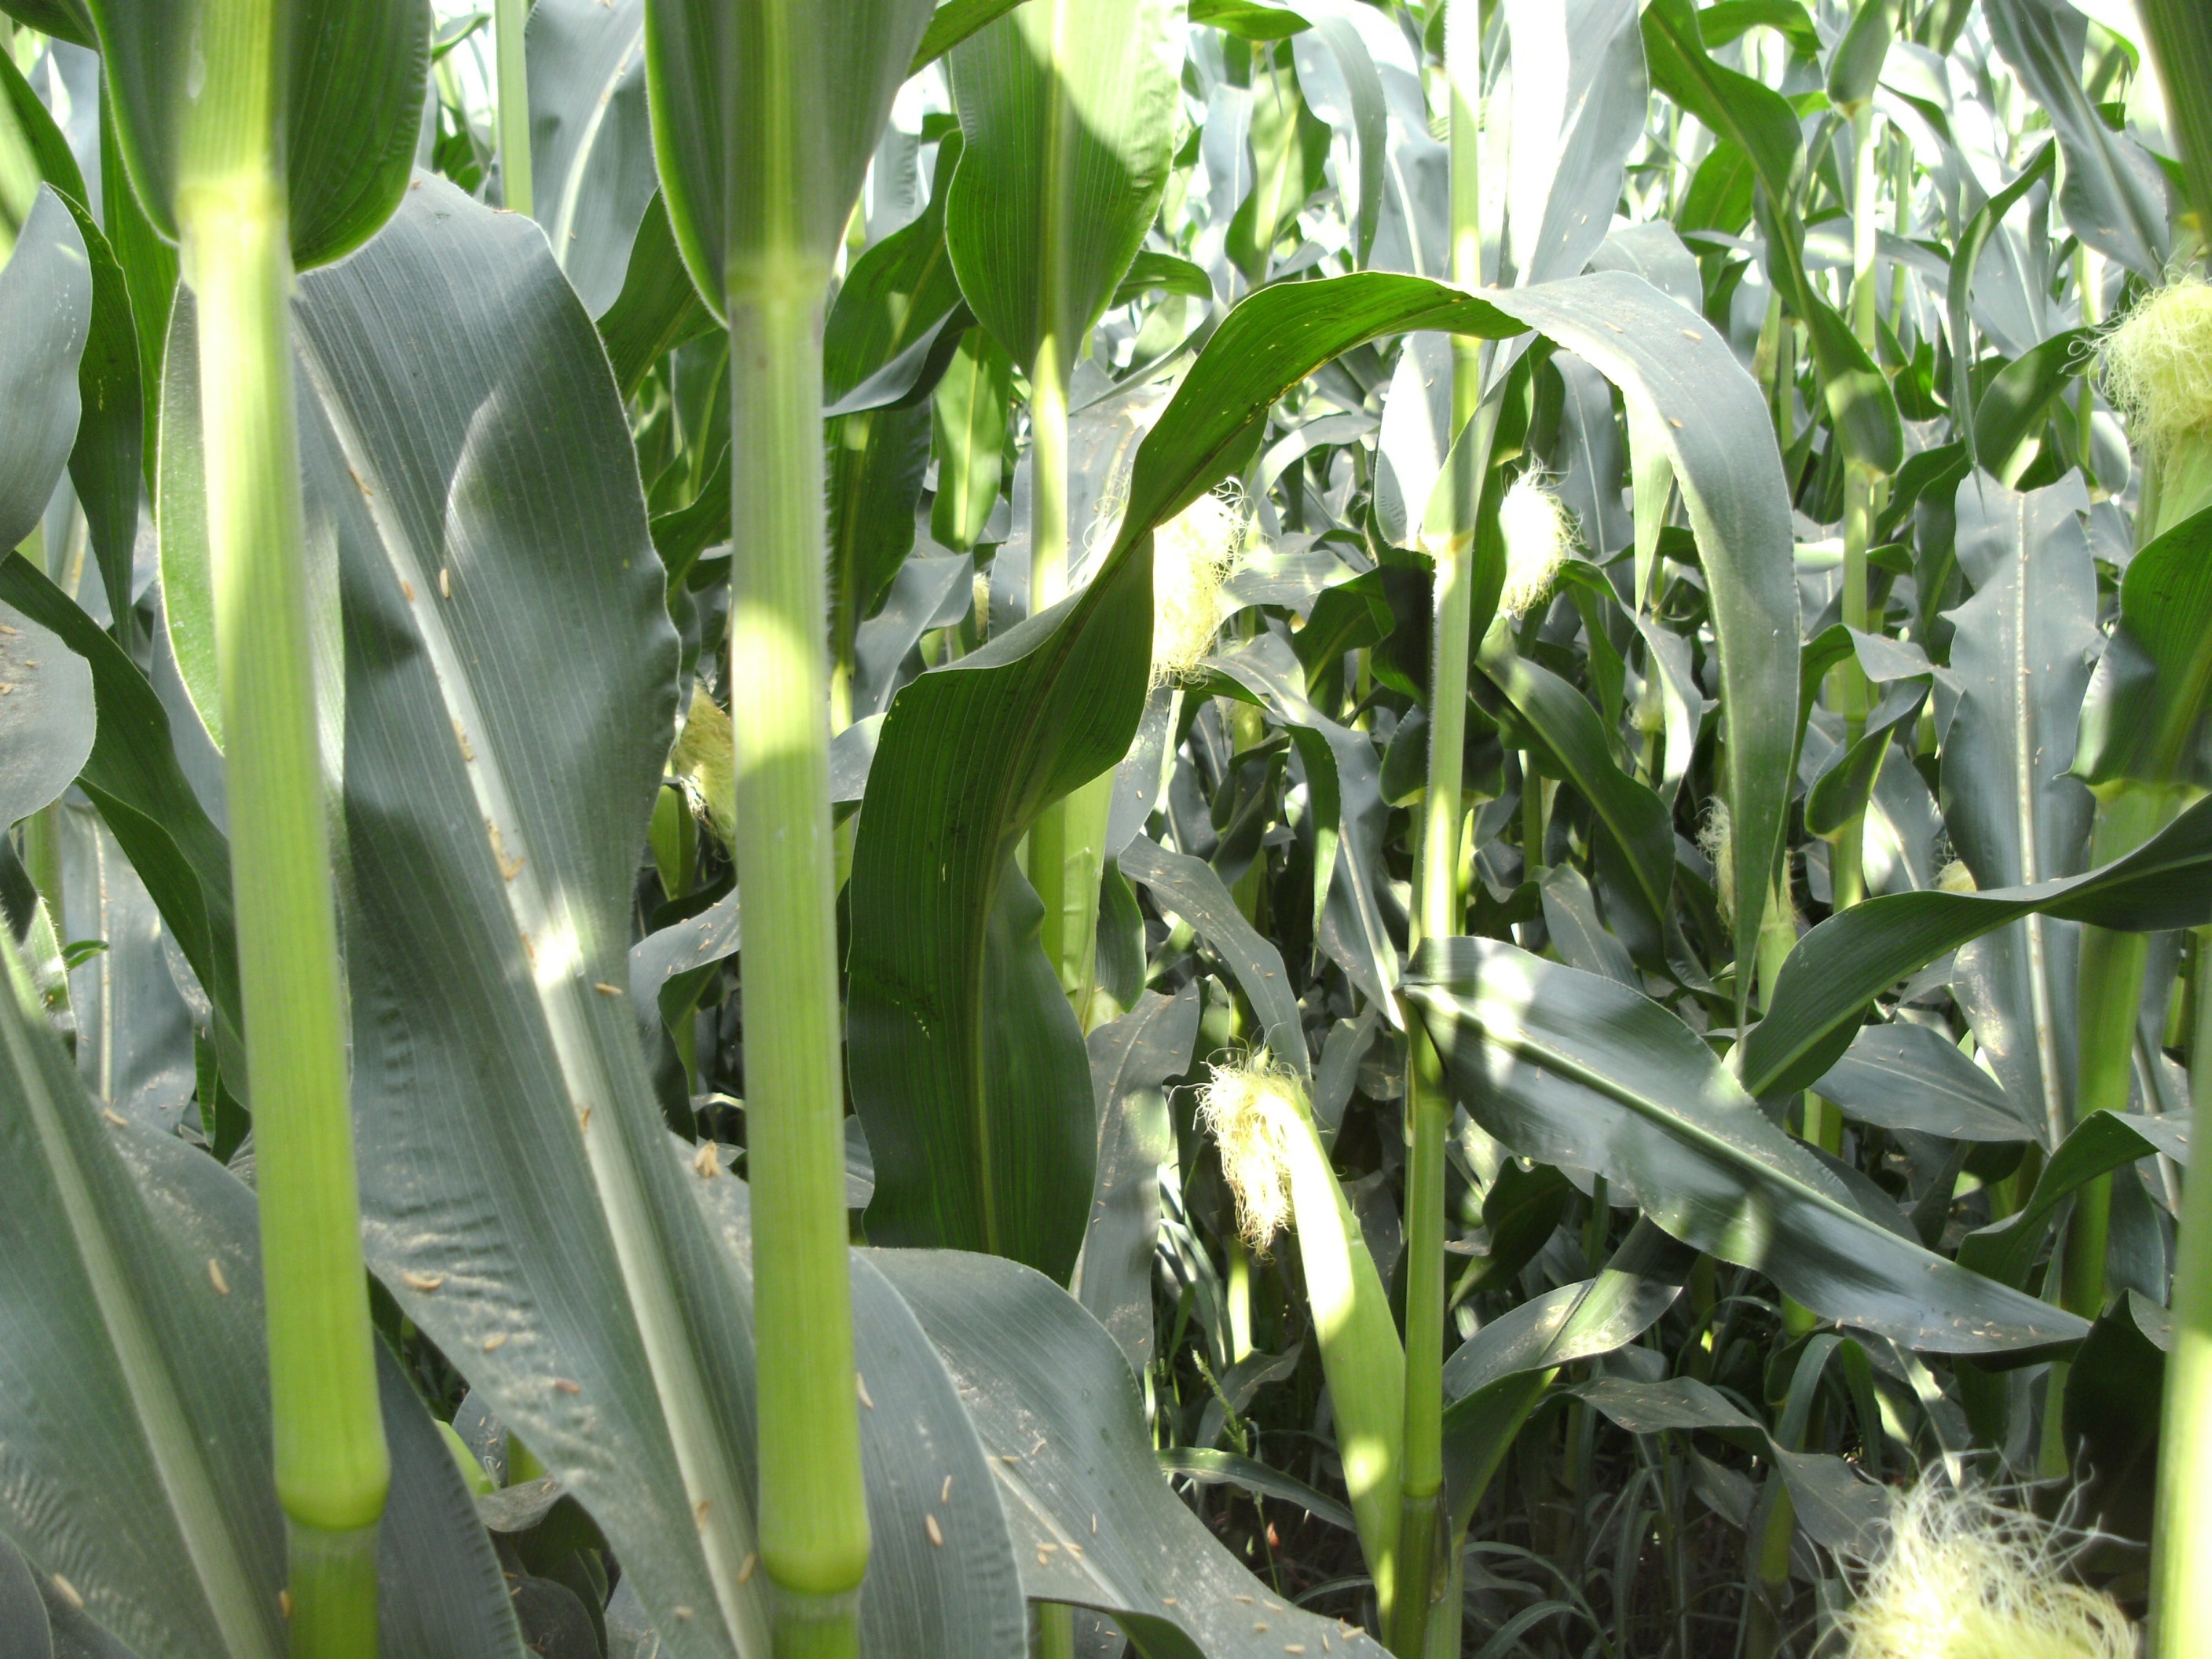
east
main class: Cropland
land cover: Maize
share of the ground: > 75 %
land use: Agriculture (excluding fallow land and kitchen gardens)
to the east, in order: Maize; Grass margins; Tracks; Broadleaved woodland; Inland fresh running water; Broadleaved woodland
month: July
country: AT
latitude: 46.7473
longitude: 14.8283
